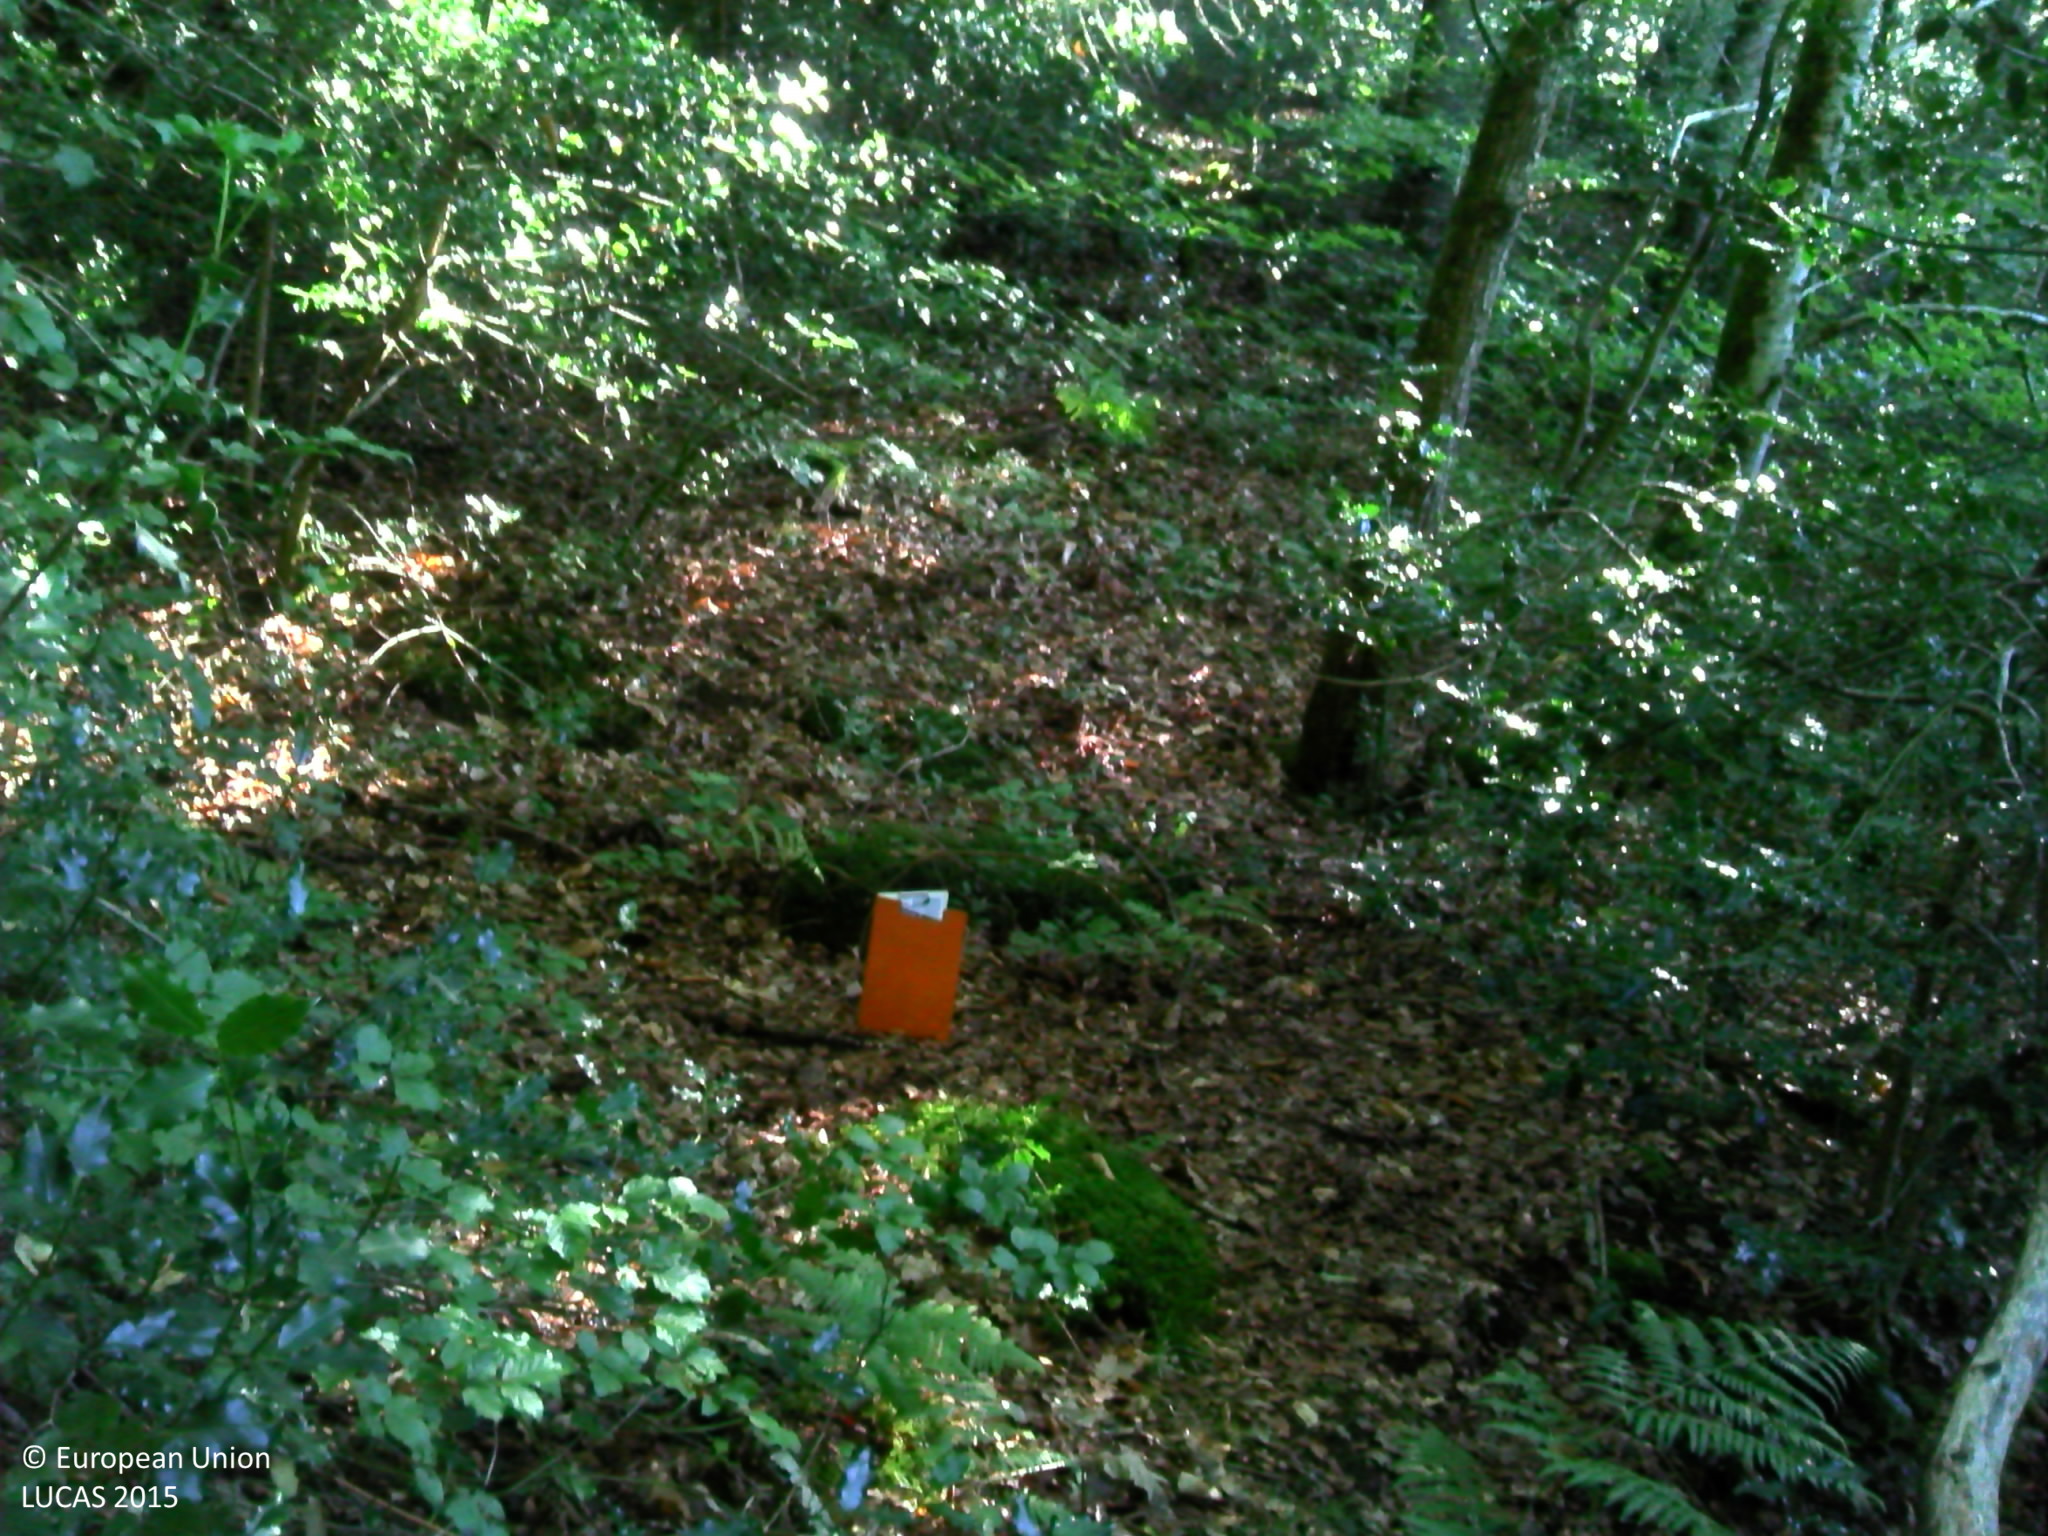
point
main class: Woodland
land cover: Broadleaved woodland
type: acidophilous oak and oak-birch forest
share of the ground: > 75 %
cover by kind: broadleaved forest trees 80 %, shrubs 20 %
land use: Forestry
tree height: > 5 m
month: July
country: FR
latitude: 44.8410
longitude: 2.5245
